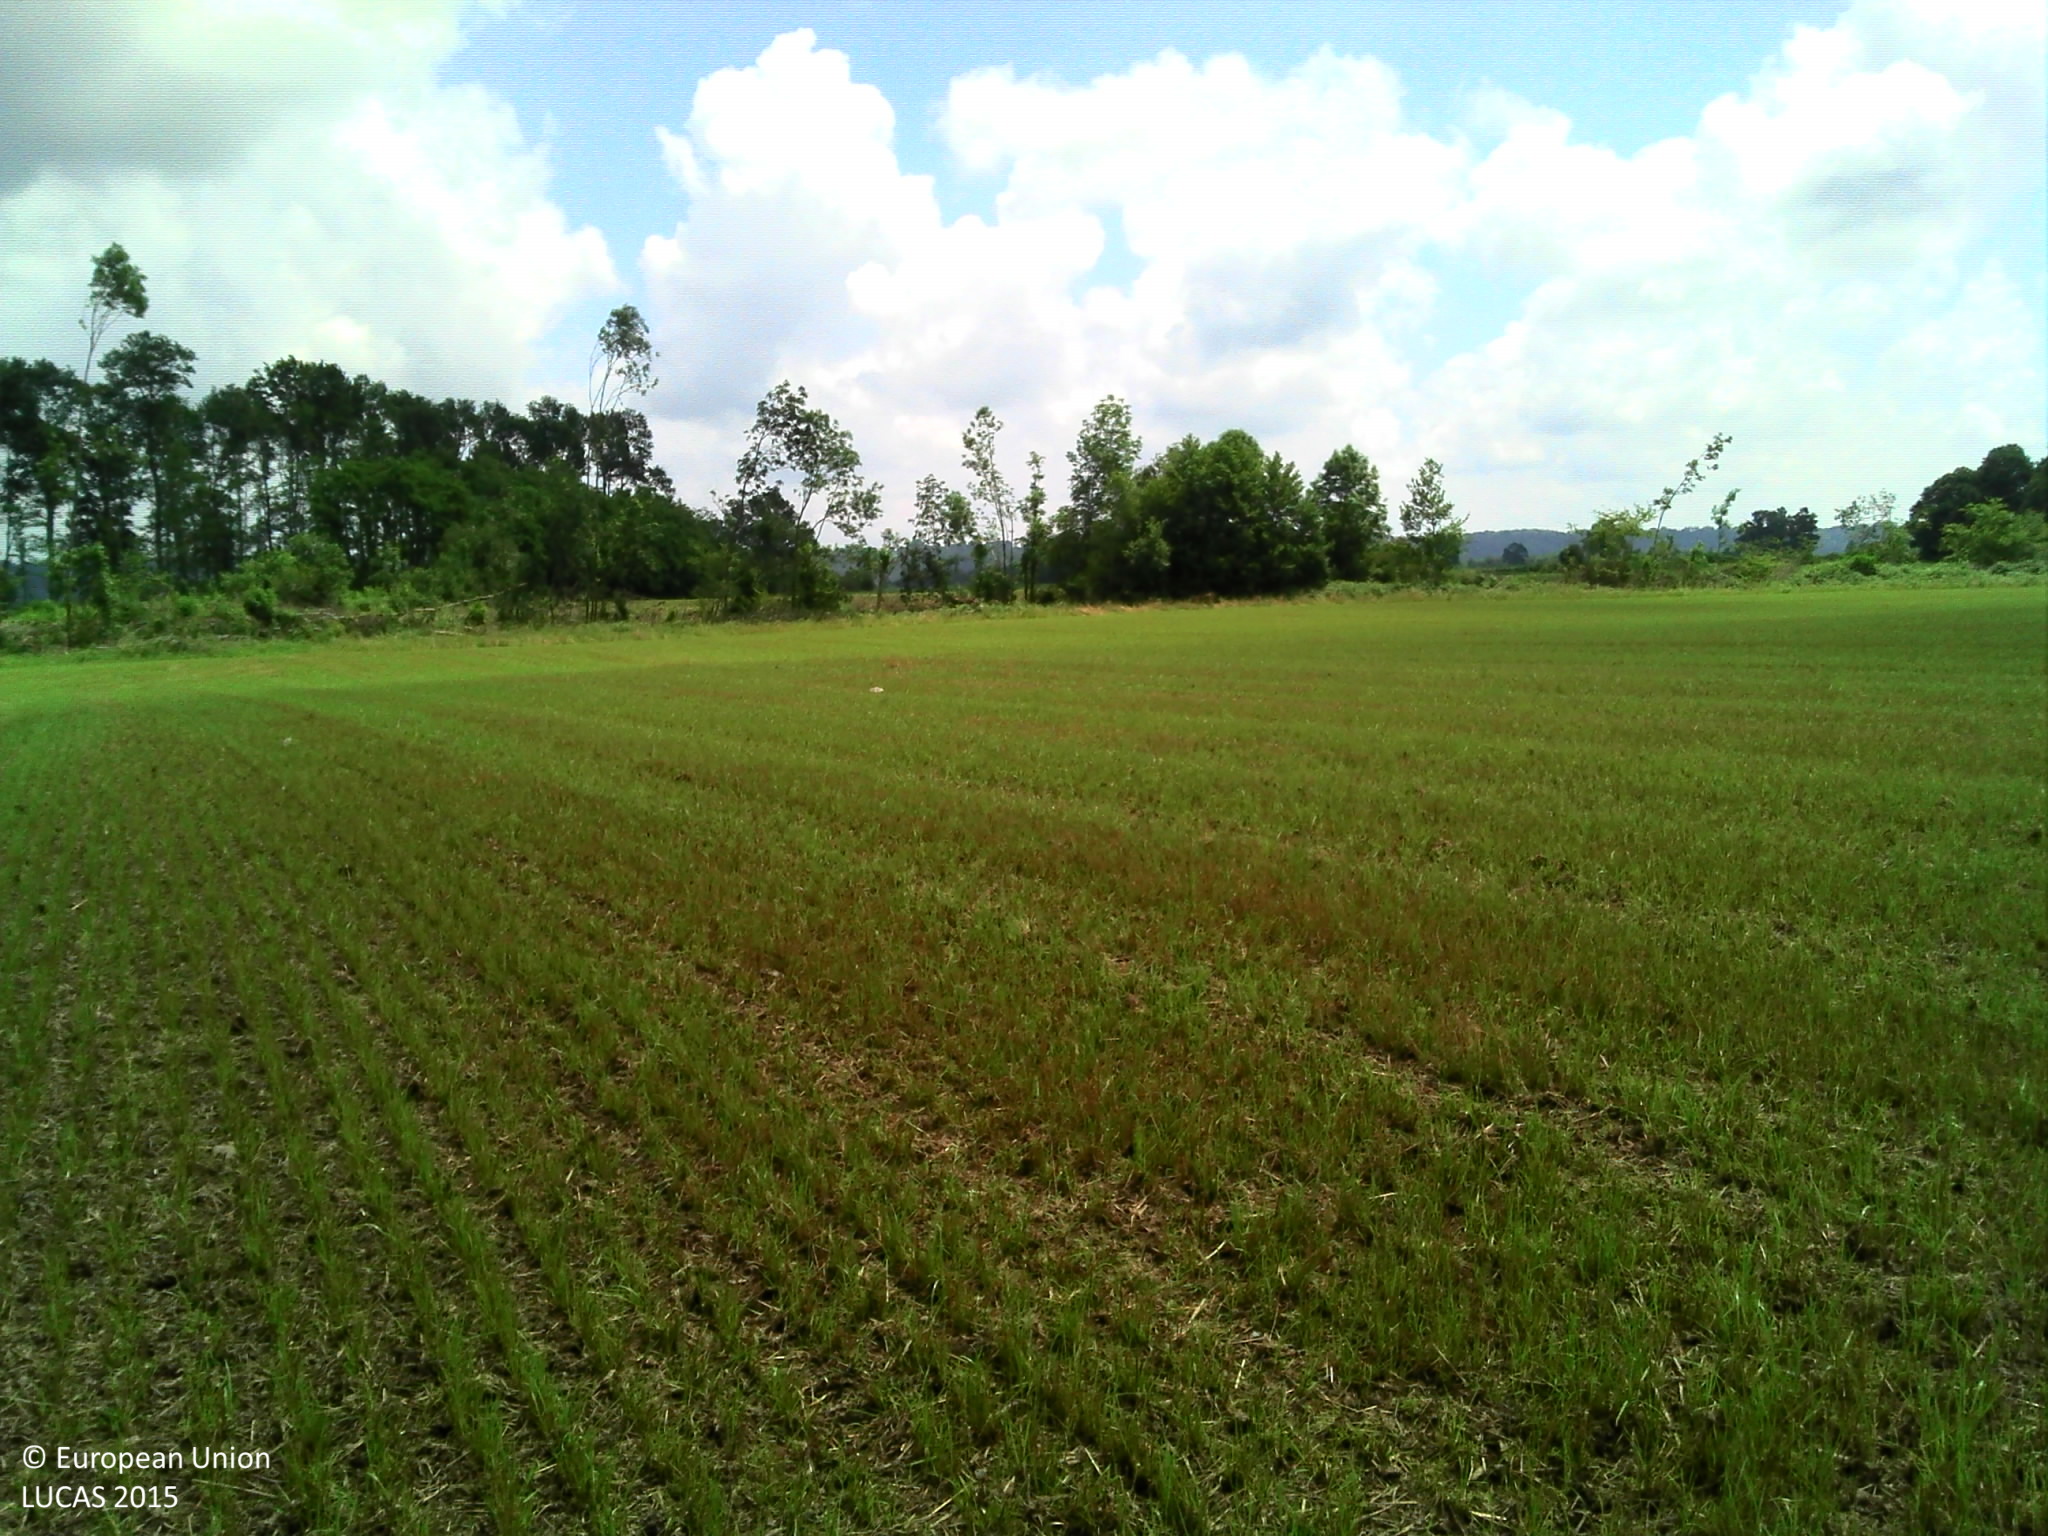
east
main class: Cropland
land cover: Temporary grasslands
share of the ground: > 75 %
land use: Agriculture (excluding fallow land and kitchen gardens)
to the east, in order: Temporary grasslands; Grassland without tree/shrub cover; Spontaneously vegetated surfaces; Rivers and streams; Abandoned hedges; Grassland without tree/shrub cover; Soya
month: June
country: FR
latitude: 43.2146
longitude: -0.1600
